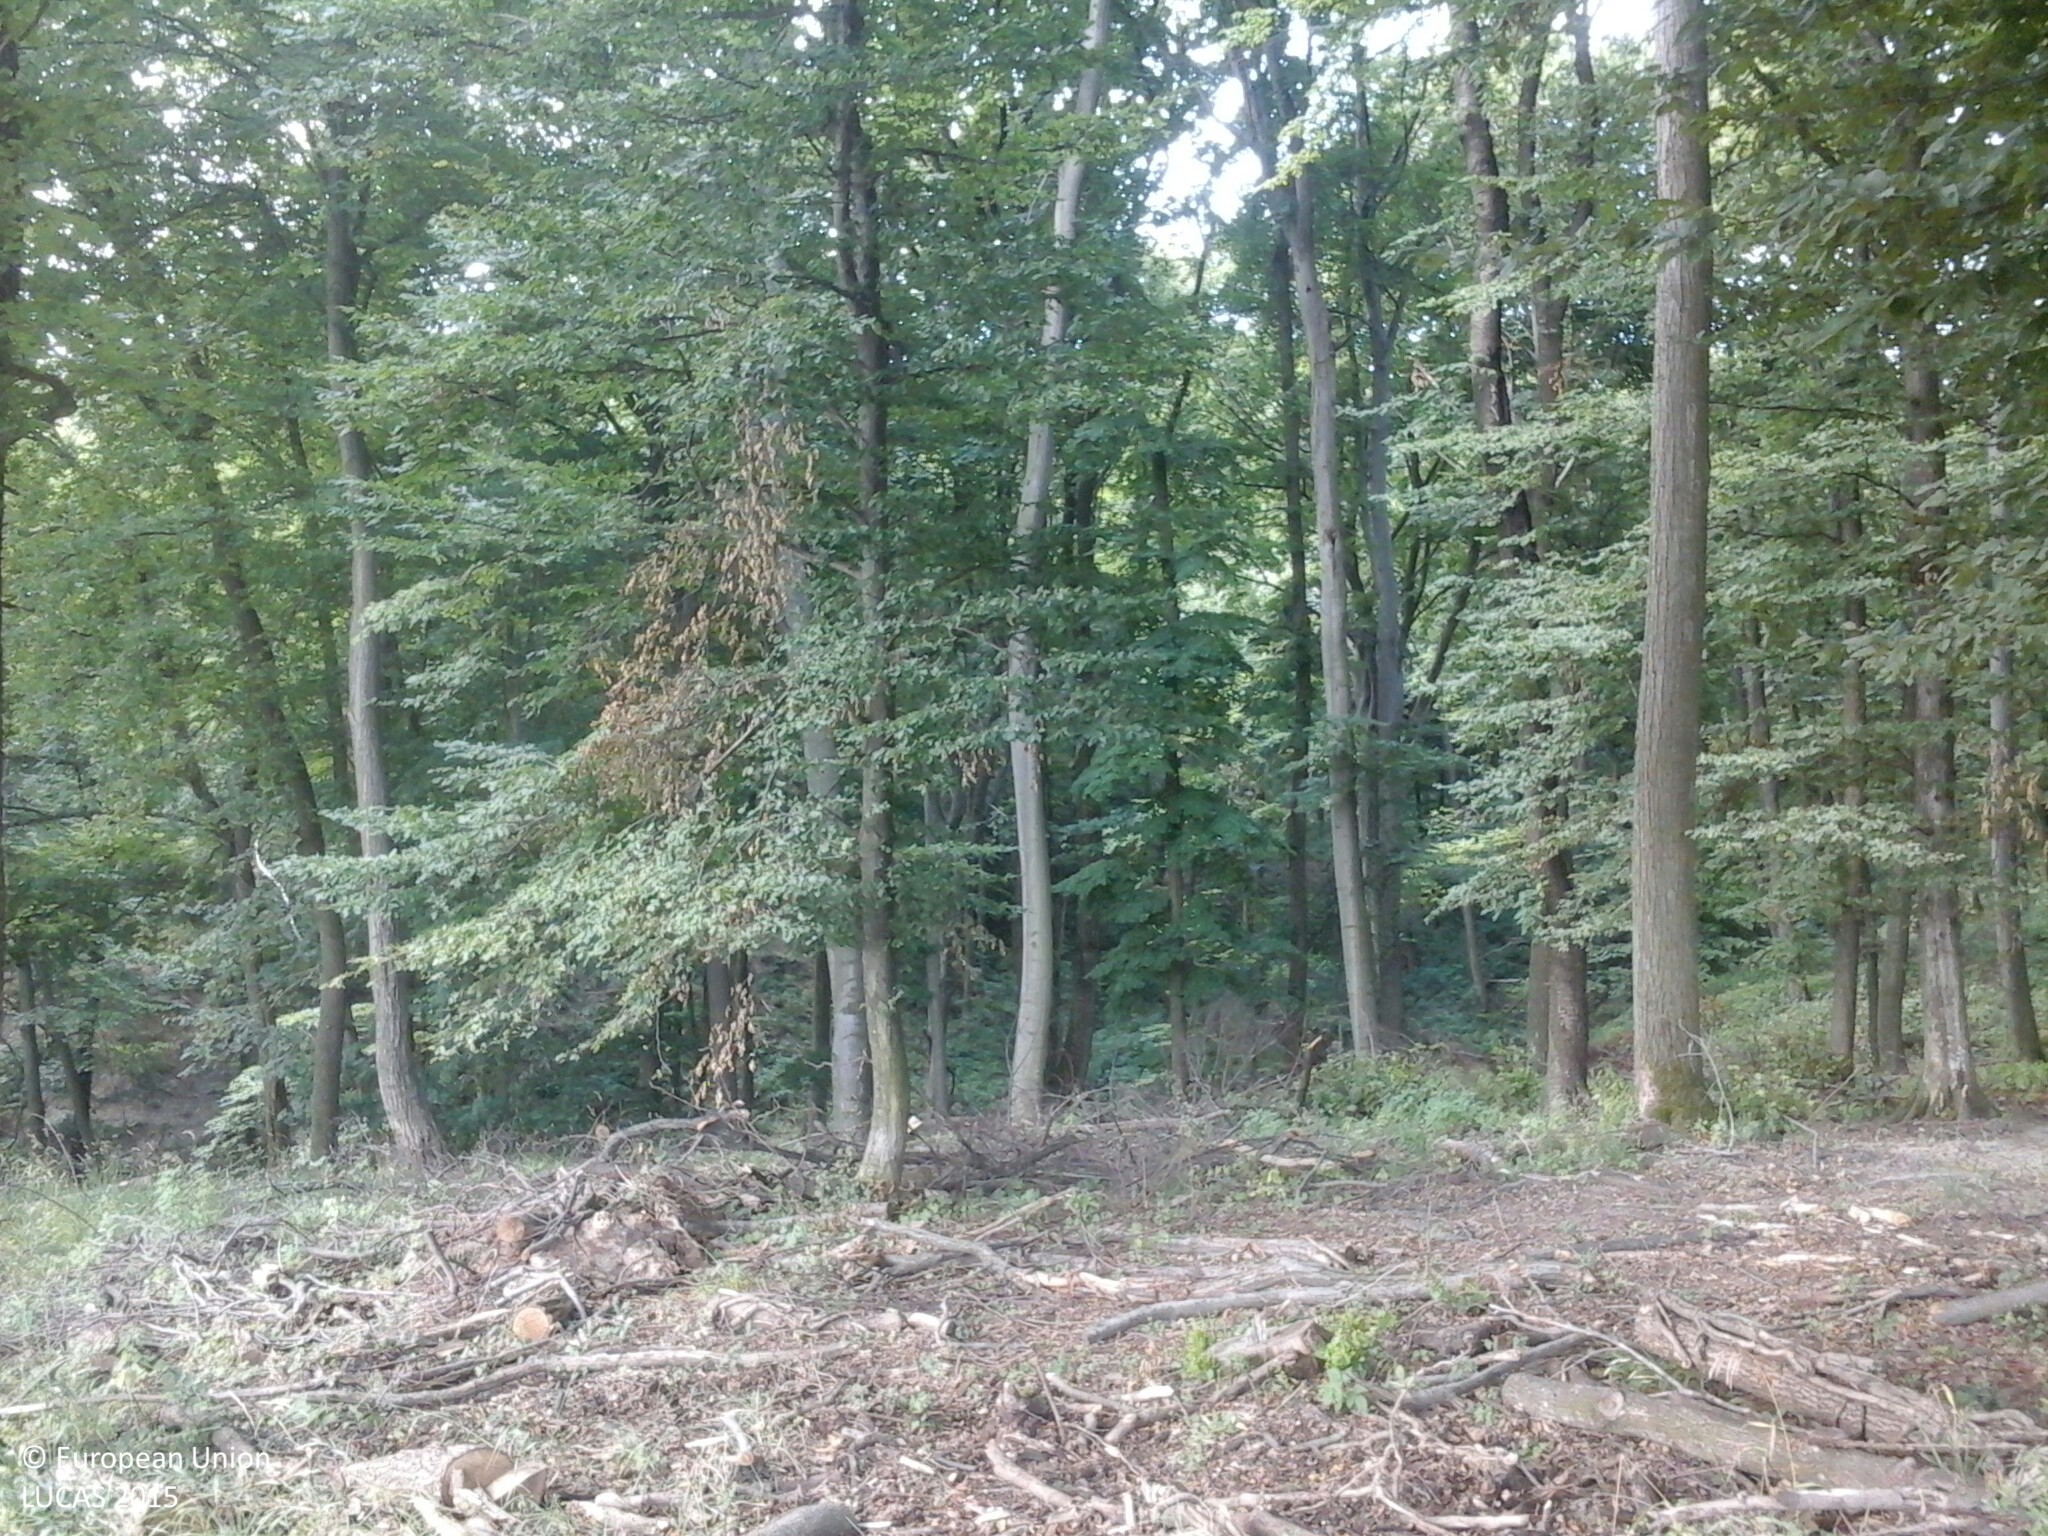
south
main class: Grassland
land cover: Grassland without tree/shrub cover
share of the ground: > 75 %
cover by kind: herbaceous plants 100 %
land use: Agriculture (excluding fallow land and kitchen gardens)
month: July
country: HU
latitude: 47.3582
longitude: 17.9405
